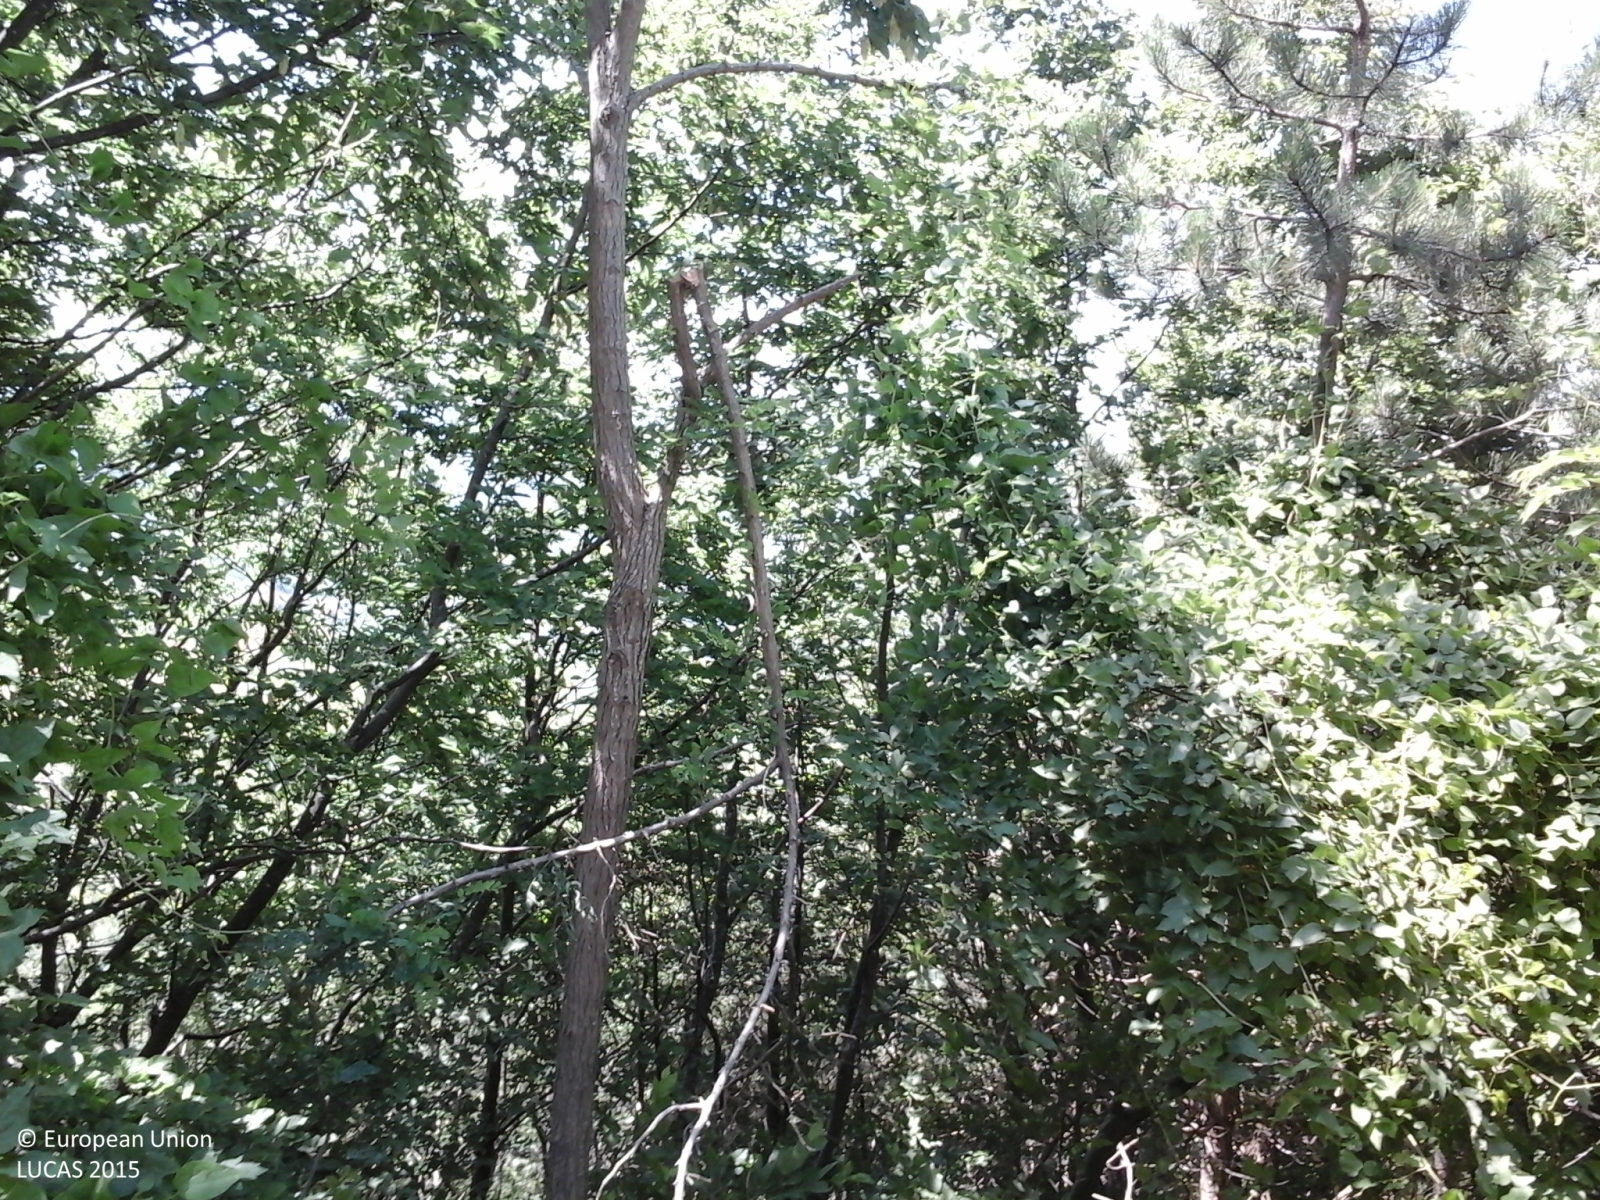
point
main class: Woodland
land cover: Broadleaved woodland
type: acidophilous oak and oak-birch forest
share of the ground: > 75 %
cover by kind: broadleaved forest trees 95 %, shrubs 5 %
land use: Forestry
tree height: > 5 m
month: June
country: IT
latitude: 44.2302
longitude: 11.5863
